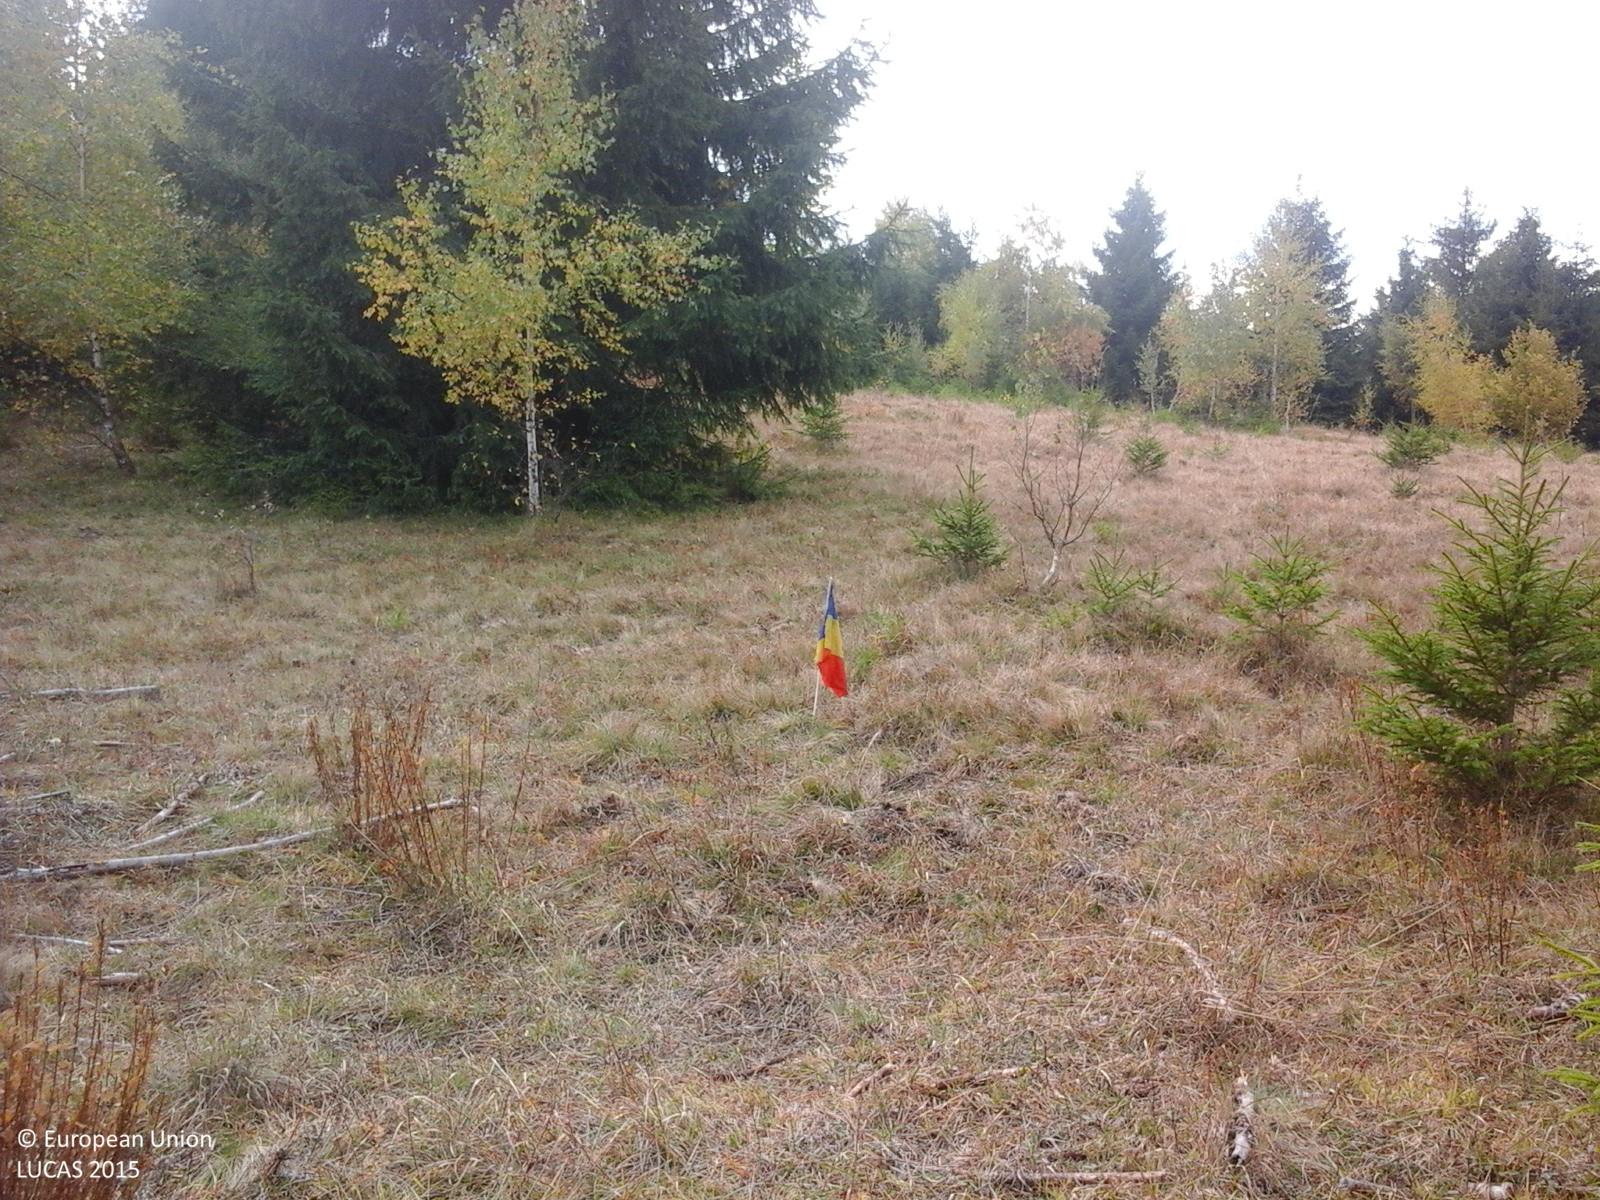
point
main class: Grassland
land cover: Grassland with sparse tree/shrub cover
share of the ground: > 75 %
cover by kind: herbaceous plants 85 %, shrubs 10 %, coniferous forest trees 5 %
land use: Forestry
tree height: < 5 m
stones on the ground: < 10 %
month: October
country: RO
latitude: 46.2896
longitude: 26.0208
